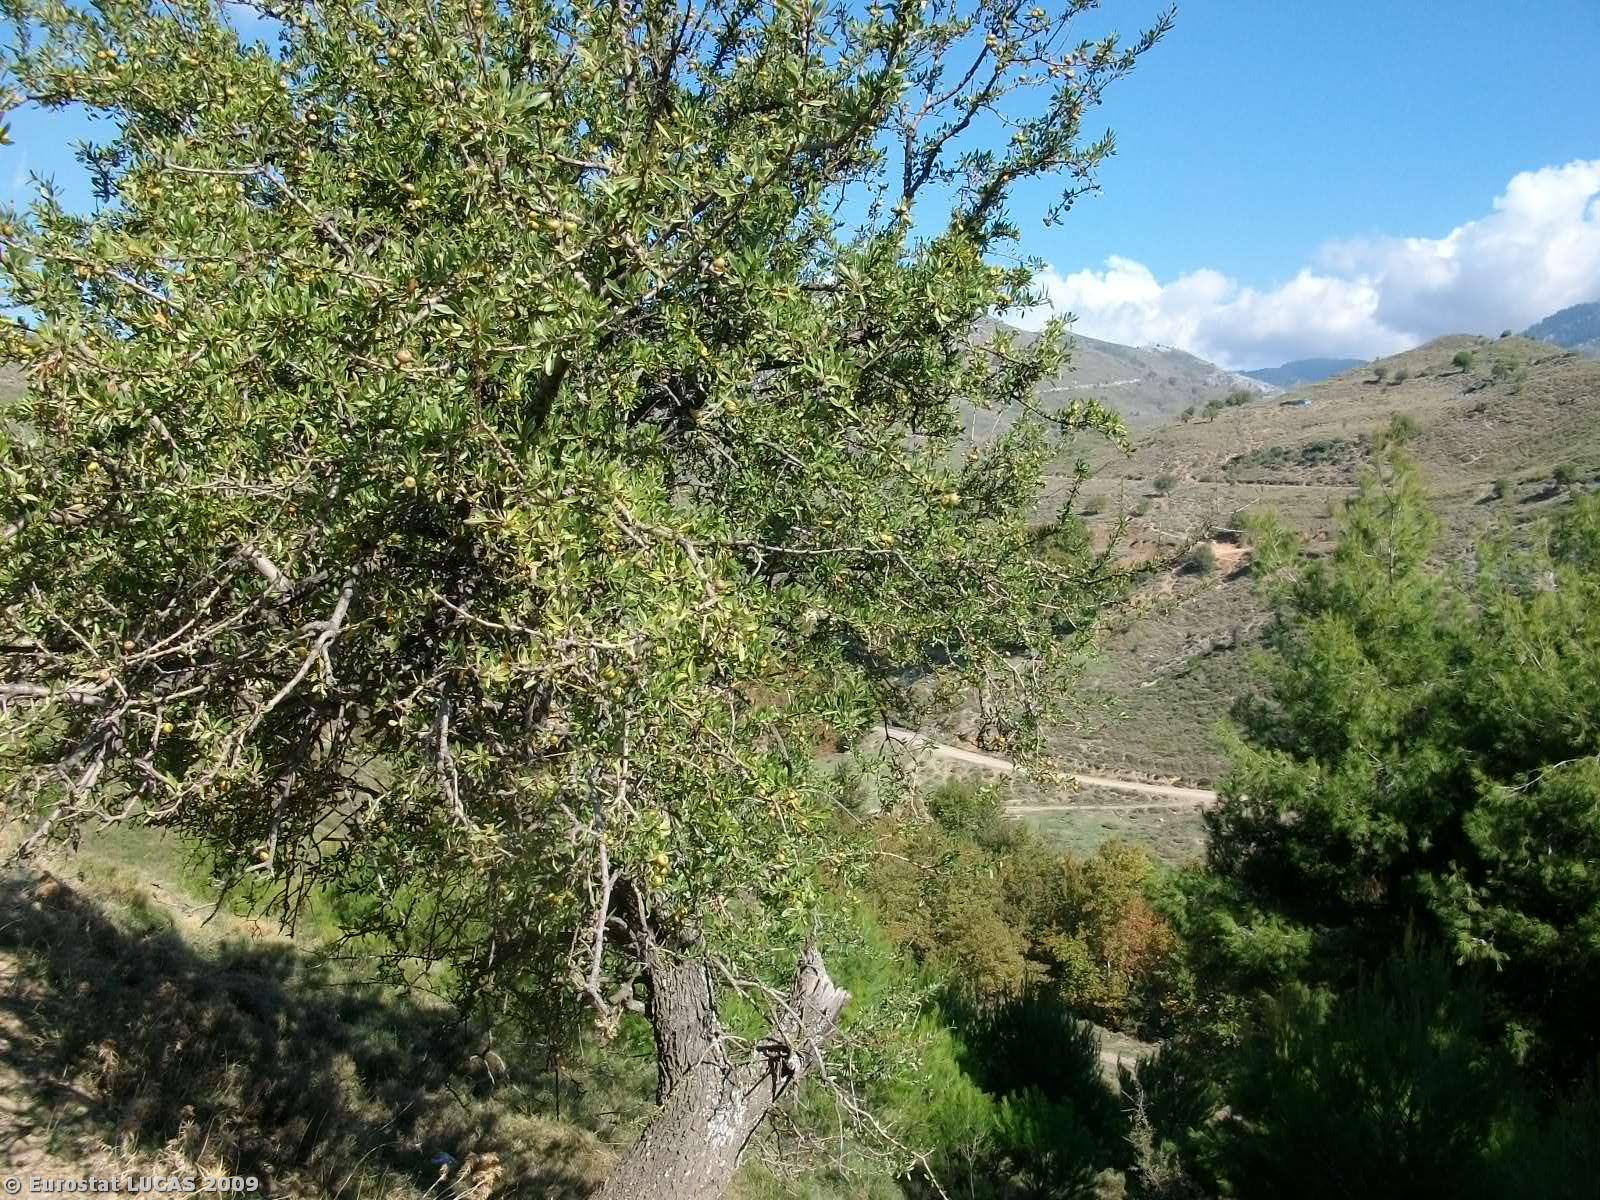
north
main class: Shrubland
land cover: Shrubland with sparse tree cover
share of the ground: > 75 %
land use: Unused
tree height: < 5 m
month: October
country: GR
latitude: 38.5446
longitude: 23.8617
